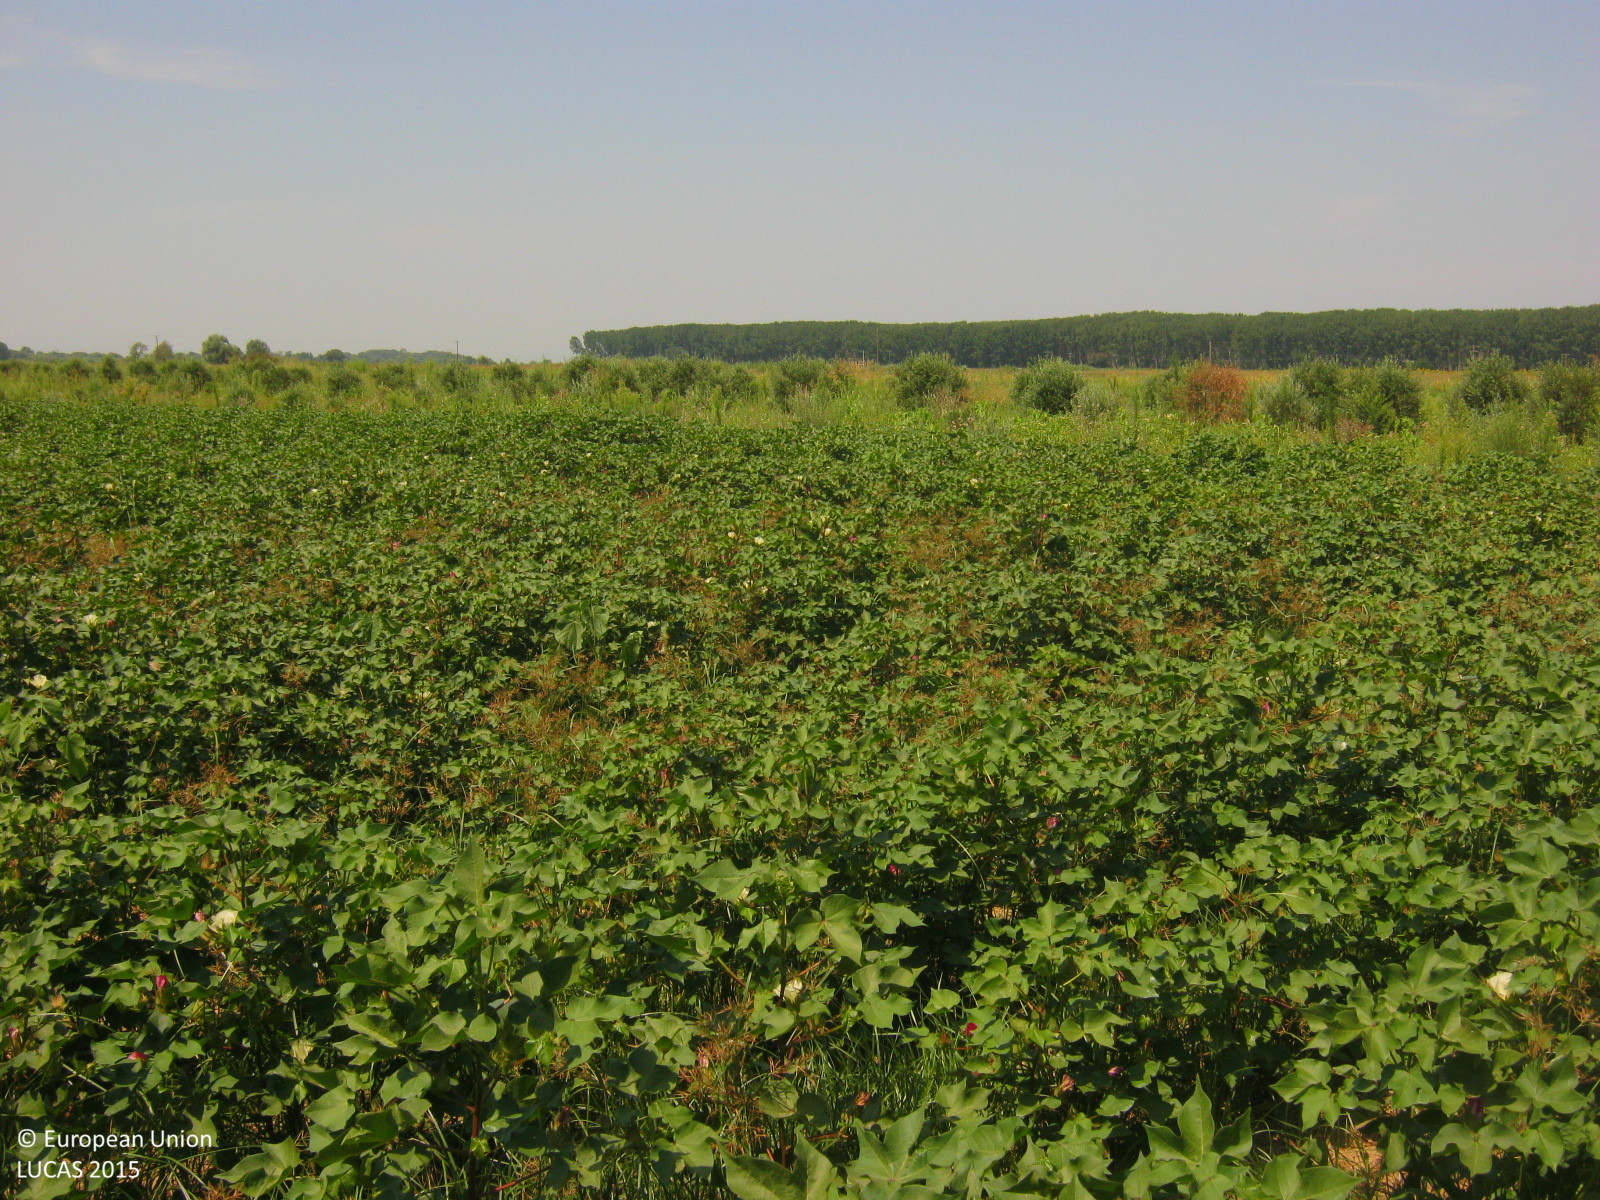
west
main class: Cropland
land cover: Cotton
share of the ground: > 75 %
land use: Agriculture (excluding fallow land and kitchen gardens)
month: July
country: GR
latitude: 41.0633
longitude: 25.1702
